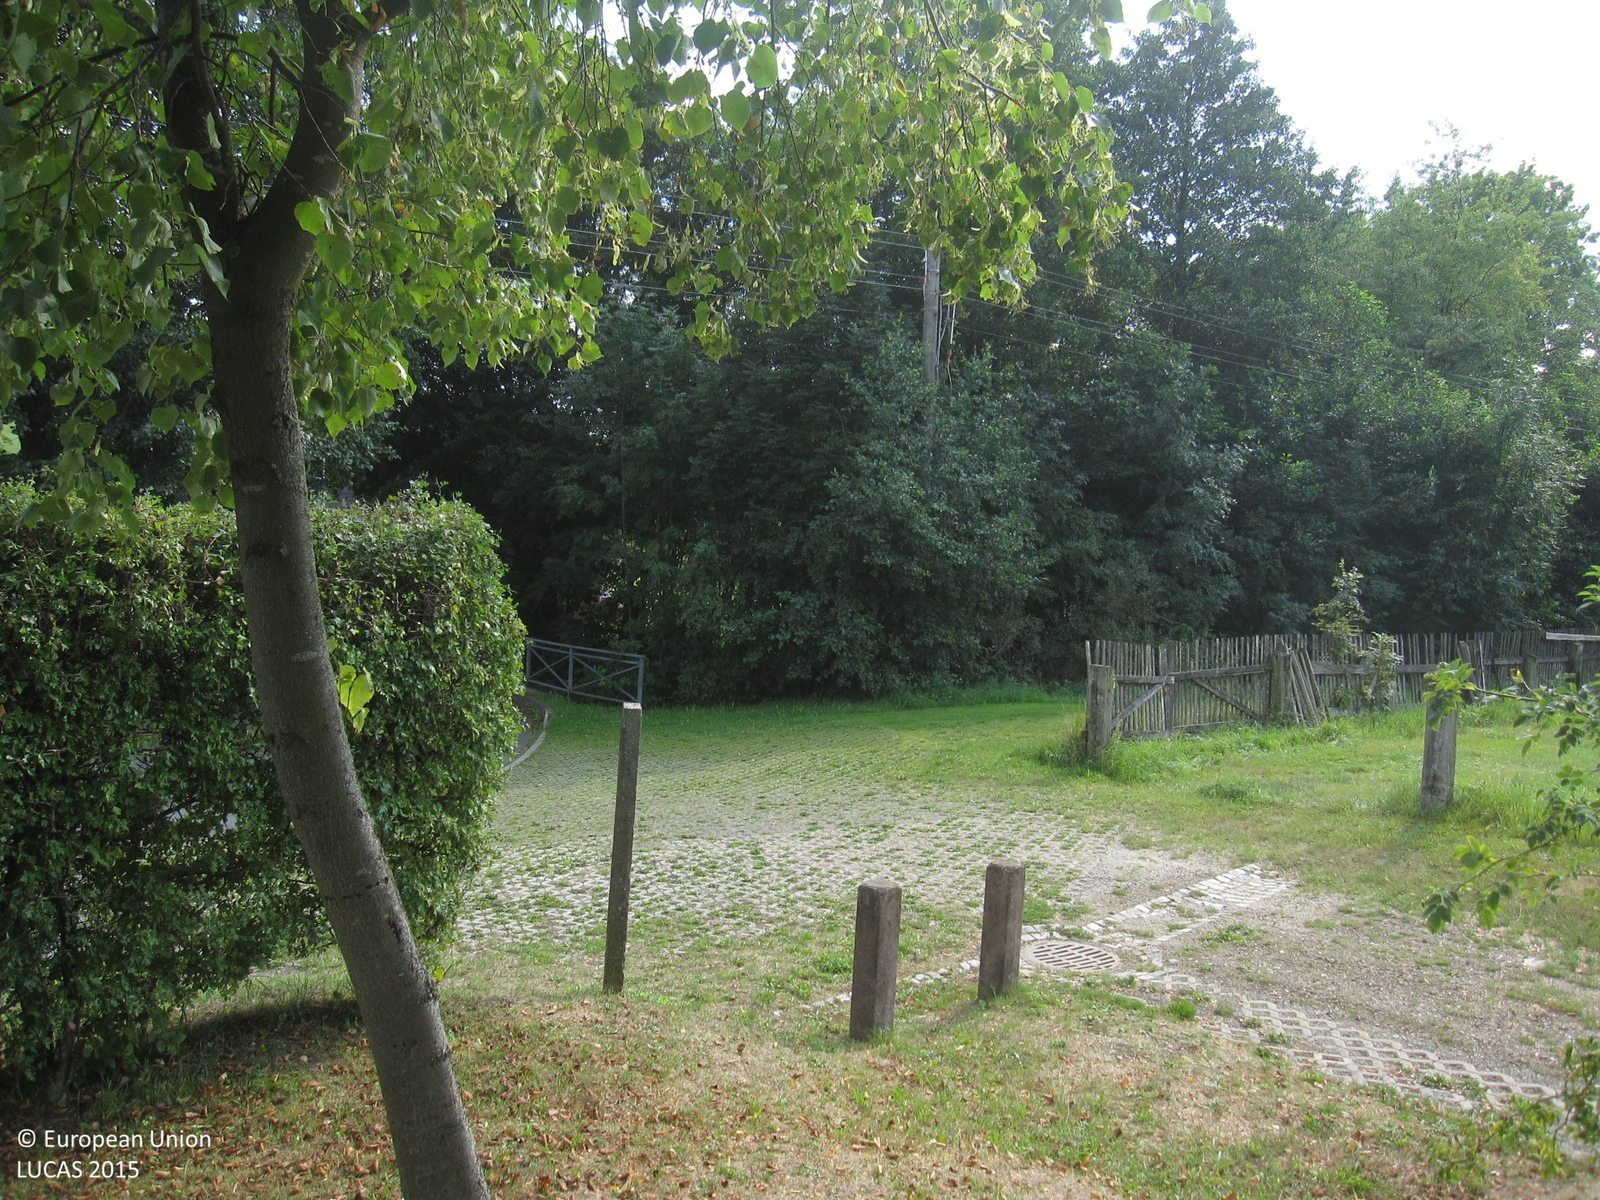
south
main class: Grassland
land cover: Grassland with sparse tree/shrub cover
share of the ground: > 75 %
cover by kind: herbaceous plants 90 %, broadleaved forest trees 5 %, consolidated bare surface 5 %
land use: Amenities, museums, leisure
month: August
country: DE
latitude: 50.4609
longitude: 11.5914
